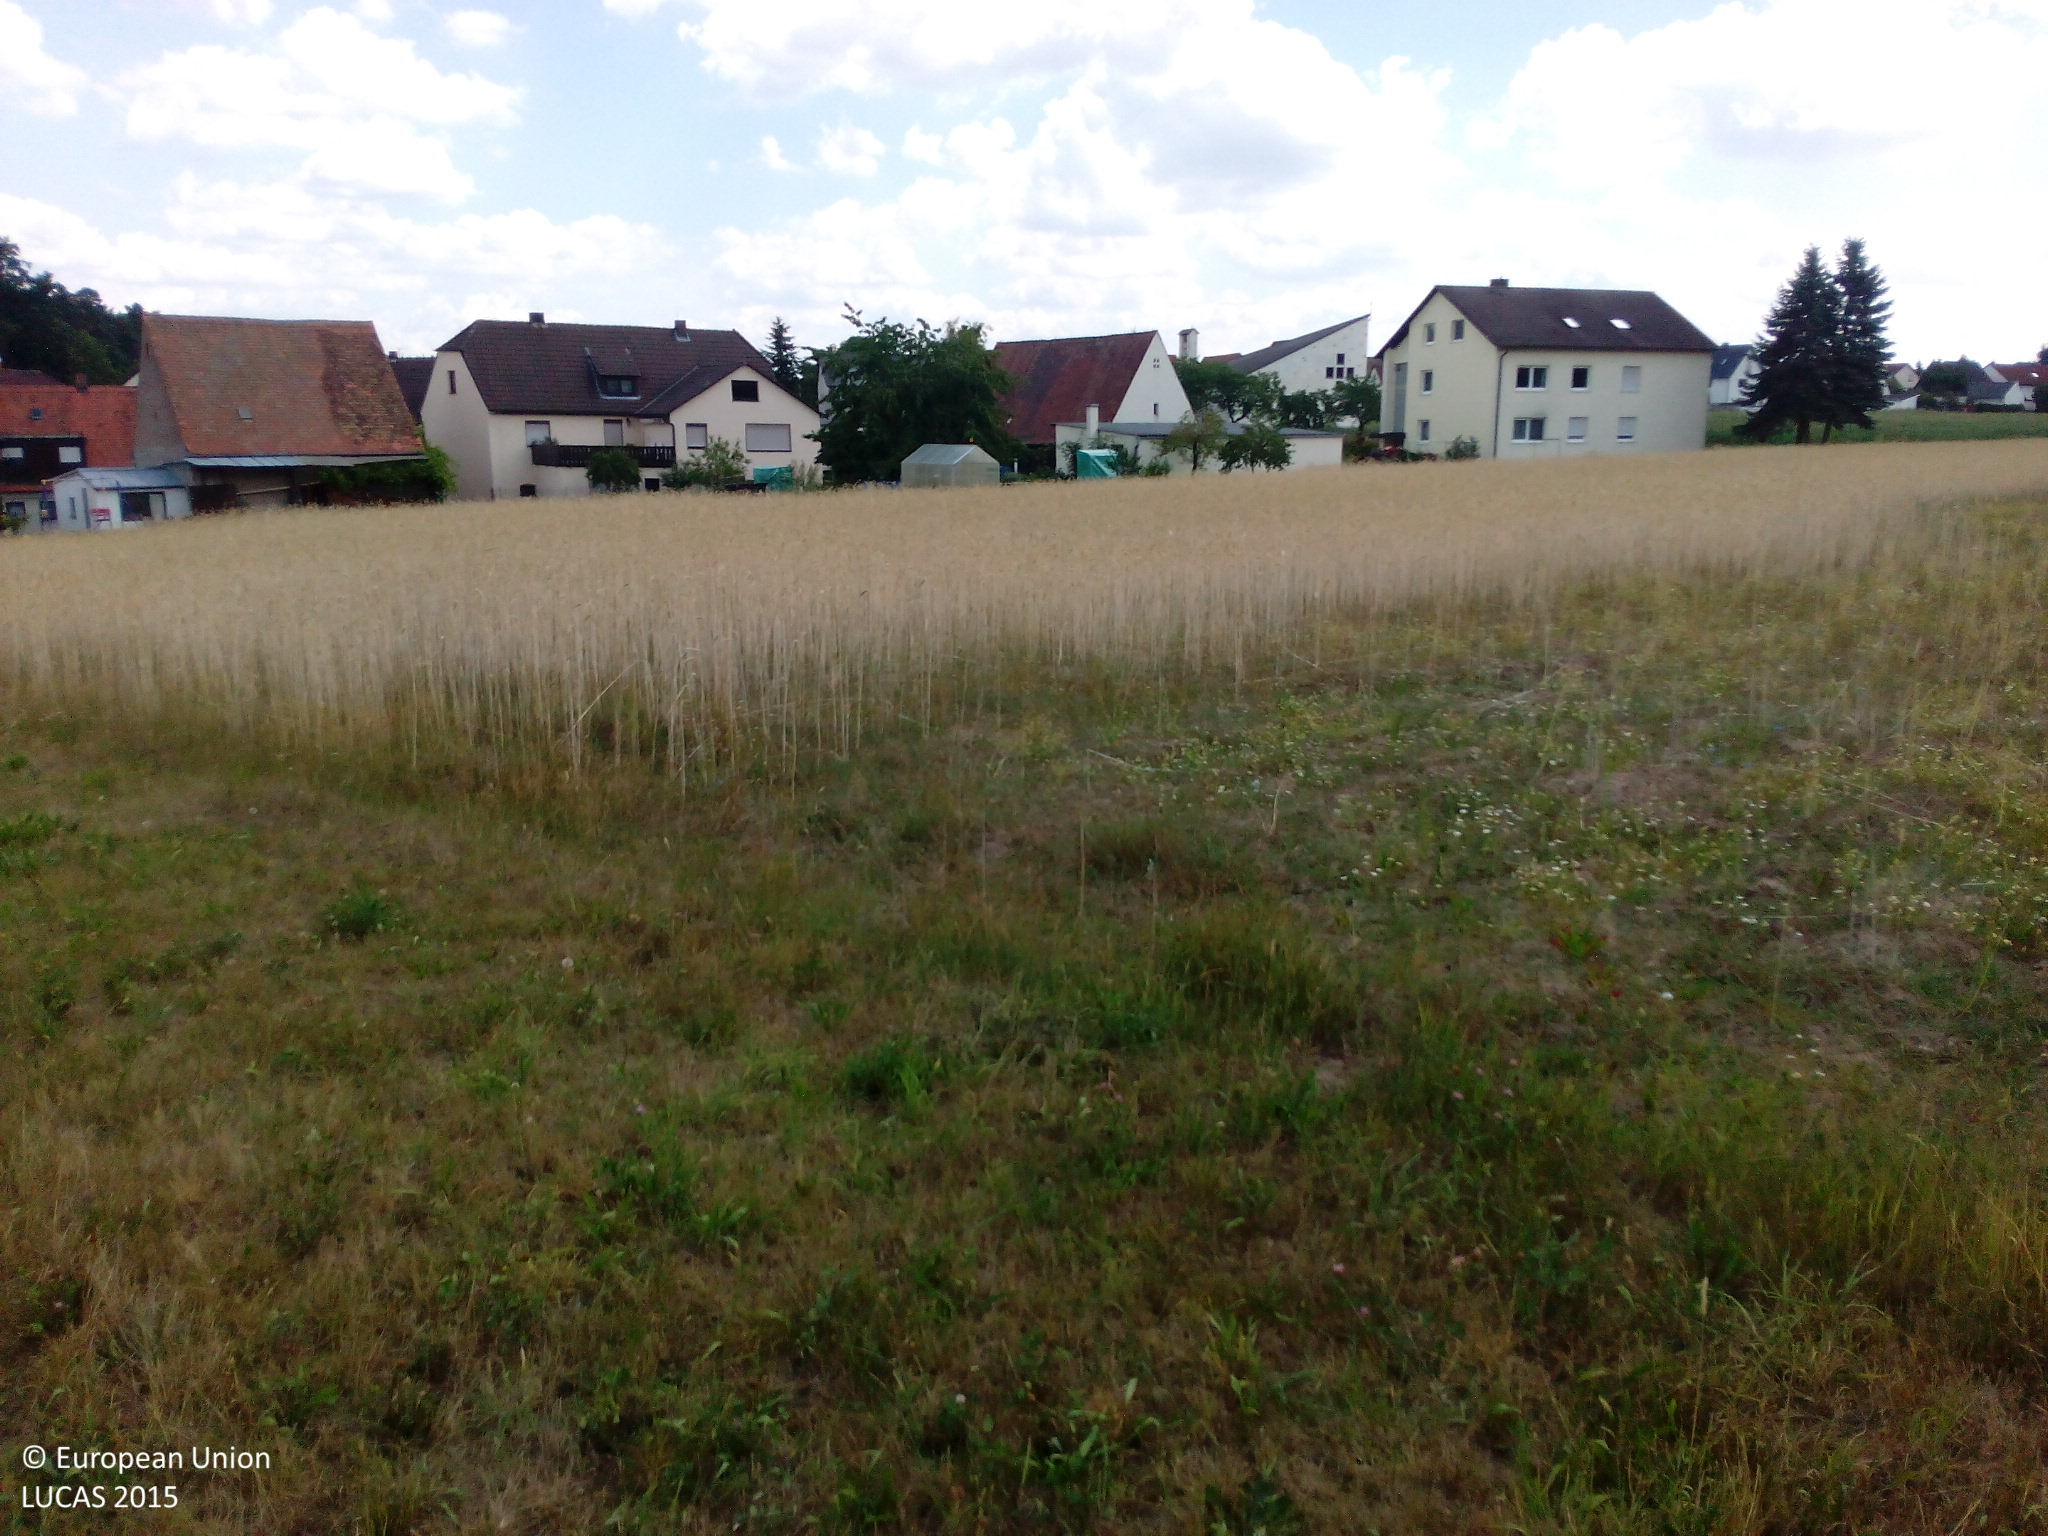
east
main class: Grassland
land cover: Grassland without tree/shrub cover
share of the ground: > 75 %
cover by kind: herbaceous plants 100 %
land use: Agriculture (excluding fallow land and kitchen gardens)
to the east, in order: Grassland without tree/shrub cover; Rye; Artificial constructions in urban areas
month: July
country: DE
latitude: 49.6949
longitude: 10.9285
